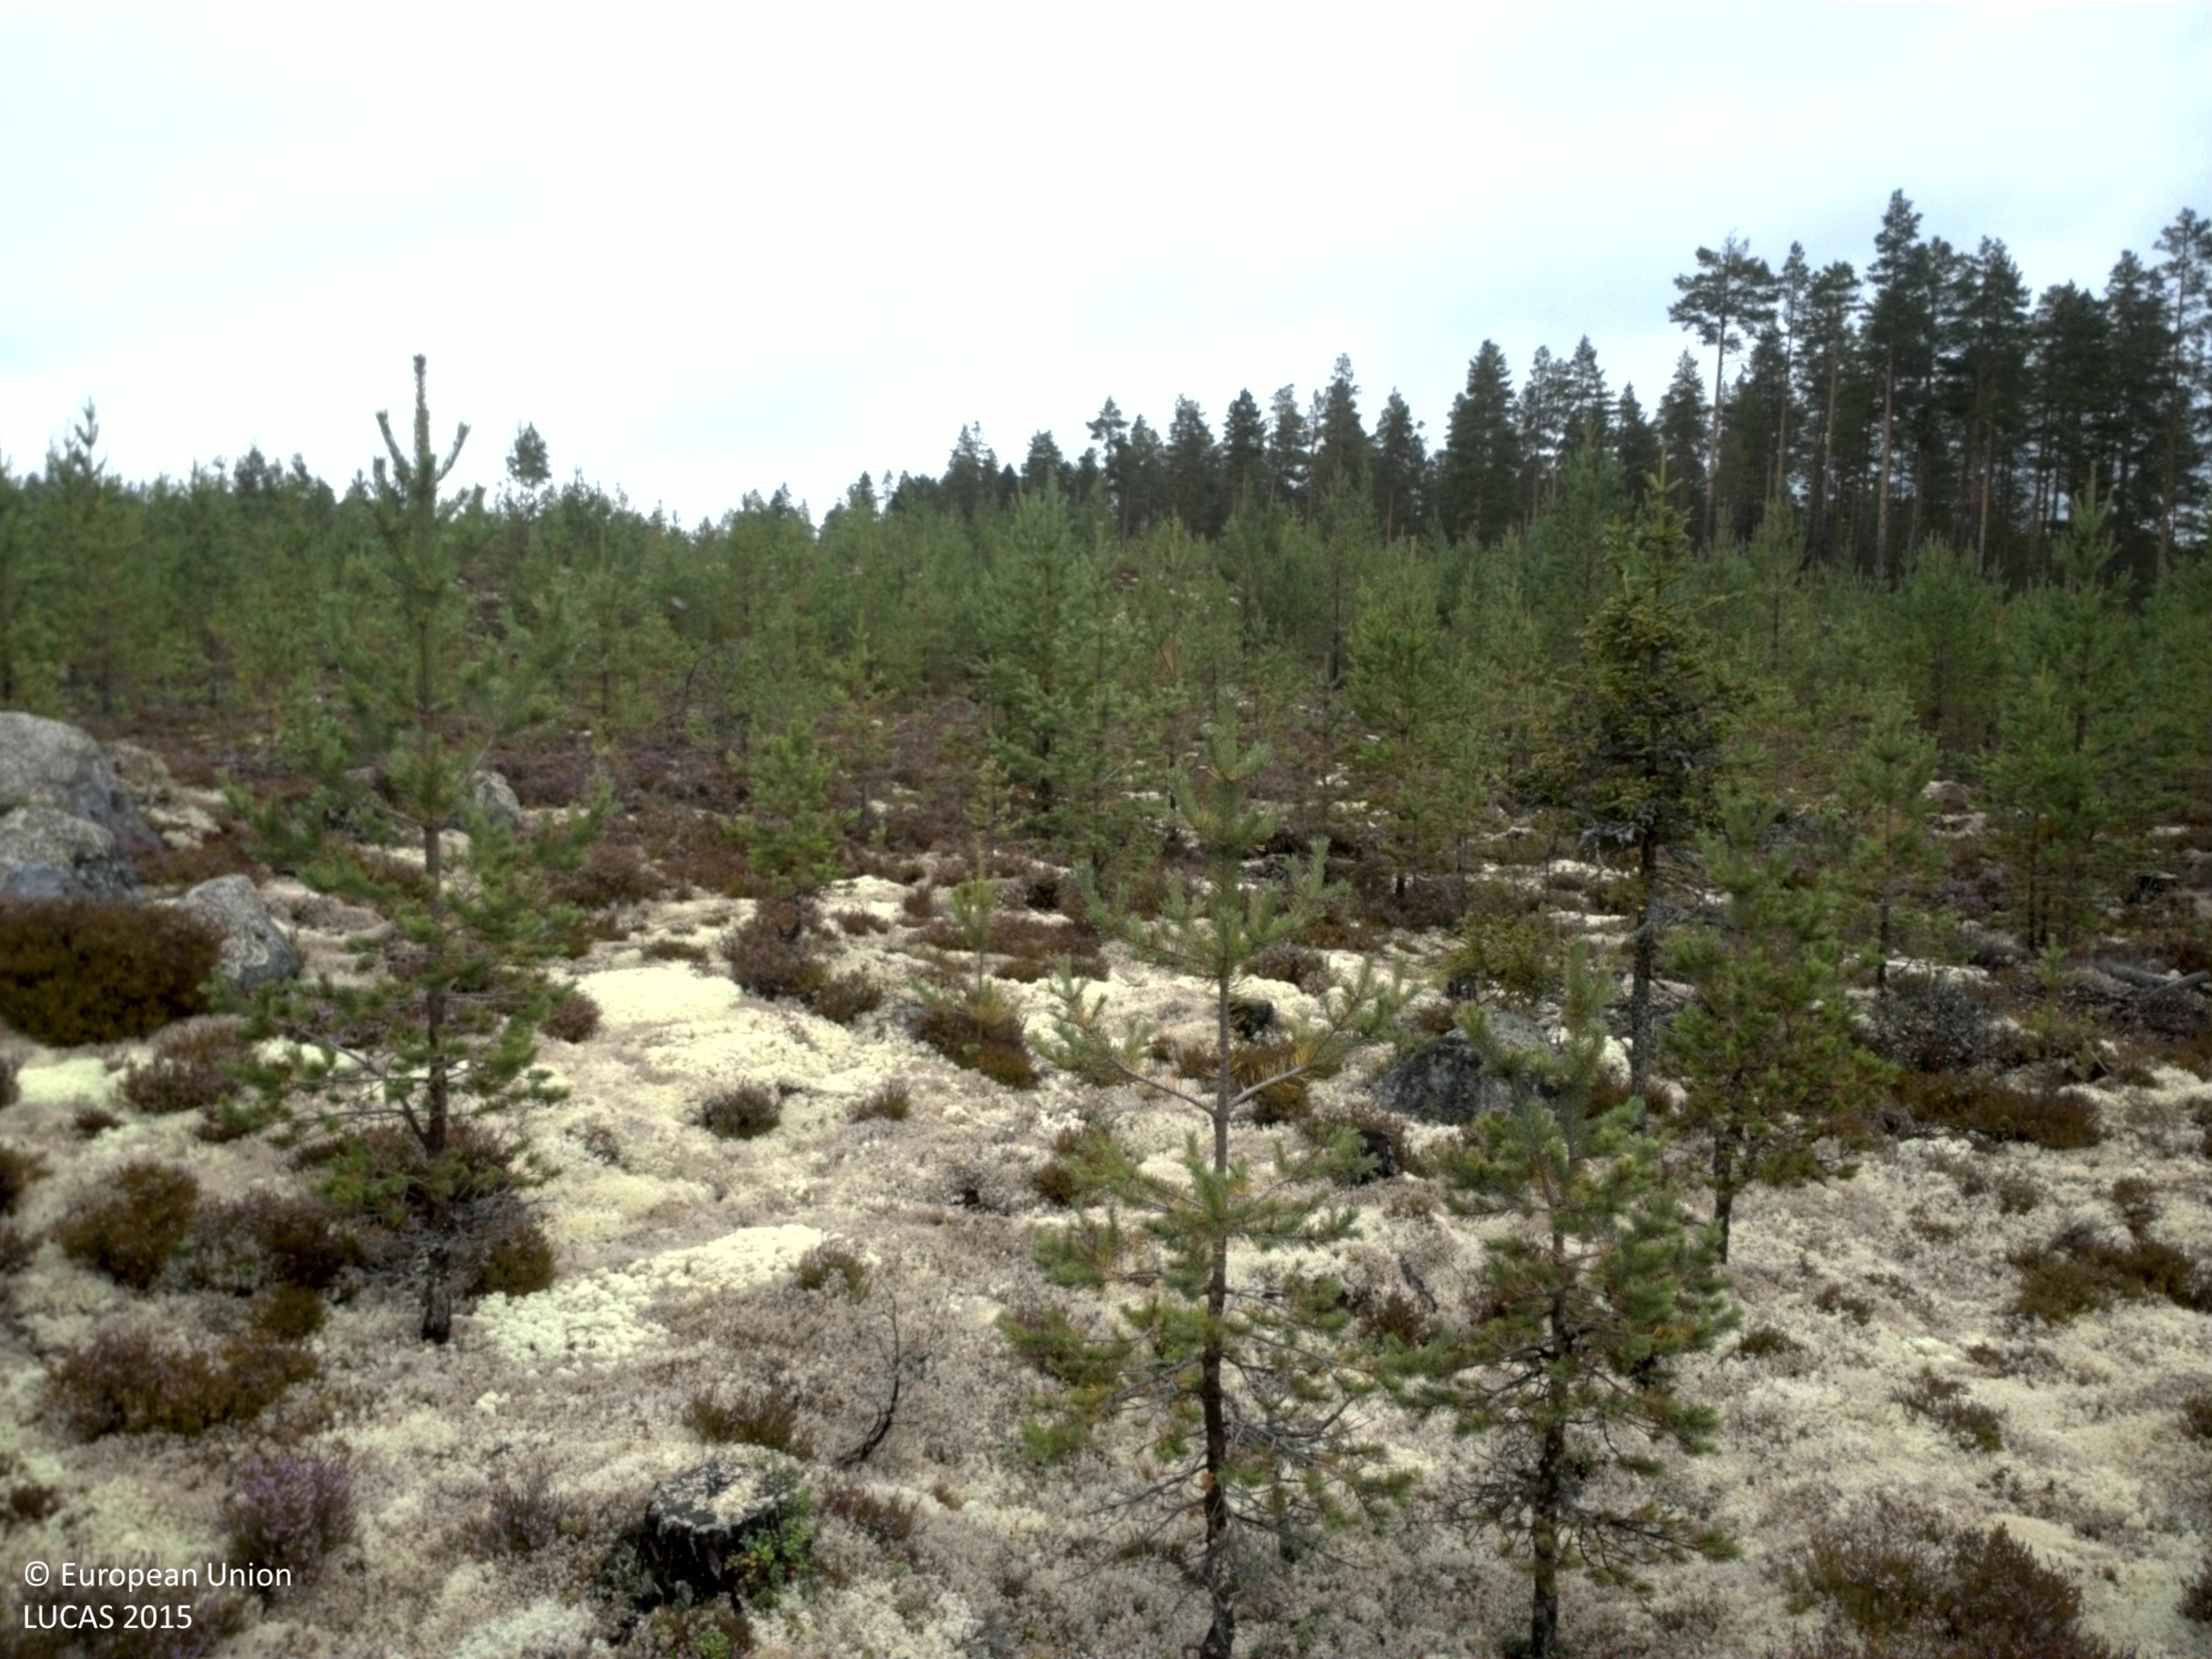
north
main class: Woodland
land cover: Pine dominated coniferous woodland
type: boreal forest
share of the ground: 10 - 25 %
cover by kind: shrubs 45 %, lichens and mosses 25 %, coniferous forest trees 20 %, consolidated bare surface 10 %
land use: Forestry
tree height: < 5 m
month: August
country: SE
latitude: 61.8282
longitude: 14.9009
